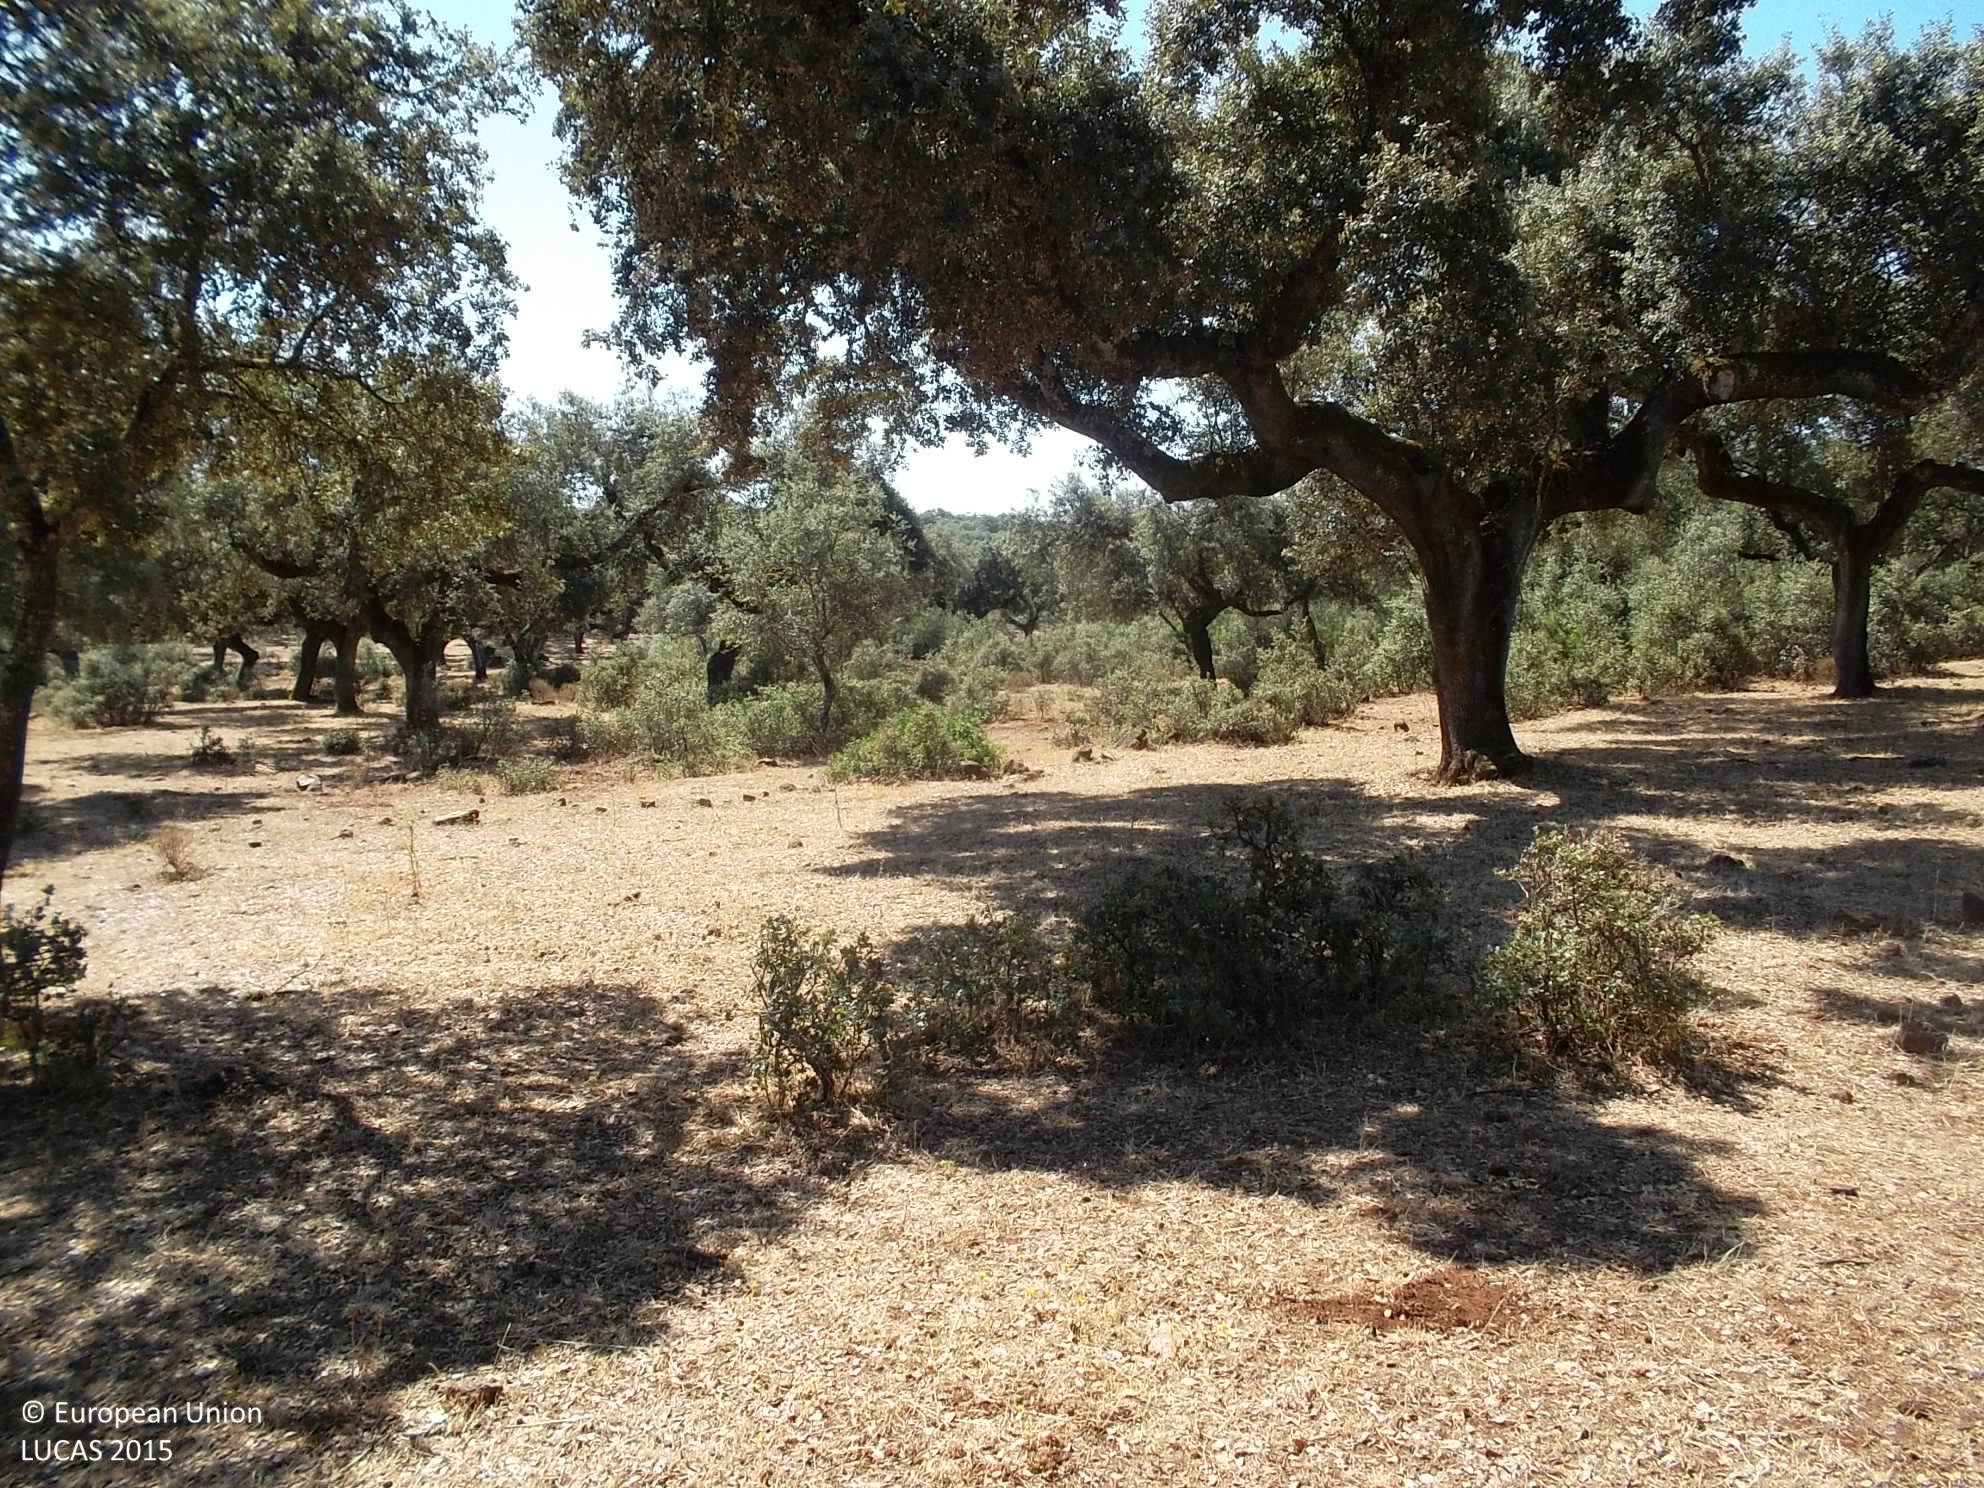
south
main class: Woodland
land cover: Broadleaved woodland
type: broadleaved evergreen forest
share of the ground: 50 - 75 %
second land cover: Grassland without tree/shrub cover
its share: 50 - 75 %
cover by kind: broadleaved forest trees 50 %, herbaceous plants 50 %
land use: Forestry
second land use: Agriculture (excluding fallow land and kitchen gardens)
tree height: > 5 m
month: August
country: ES
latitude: 38.2388
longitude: -6.6756
